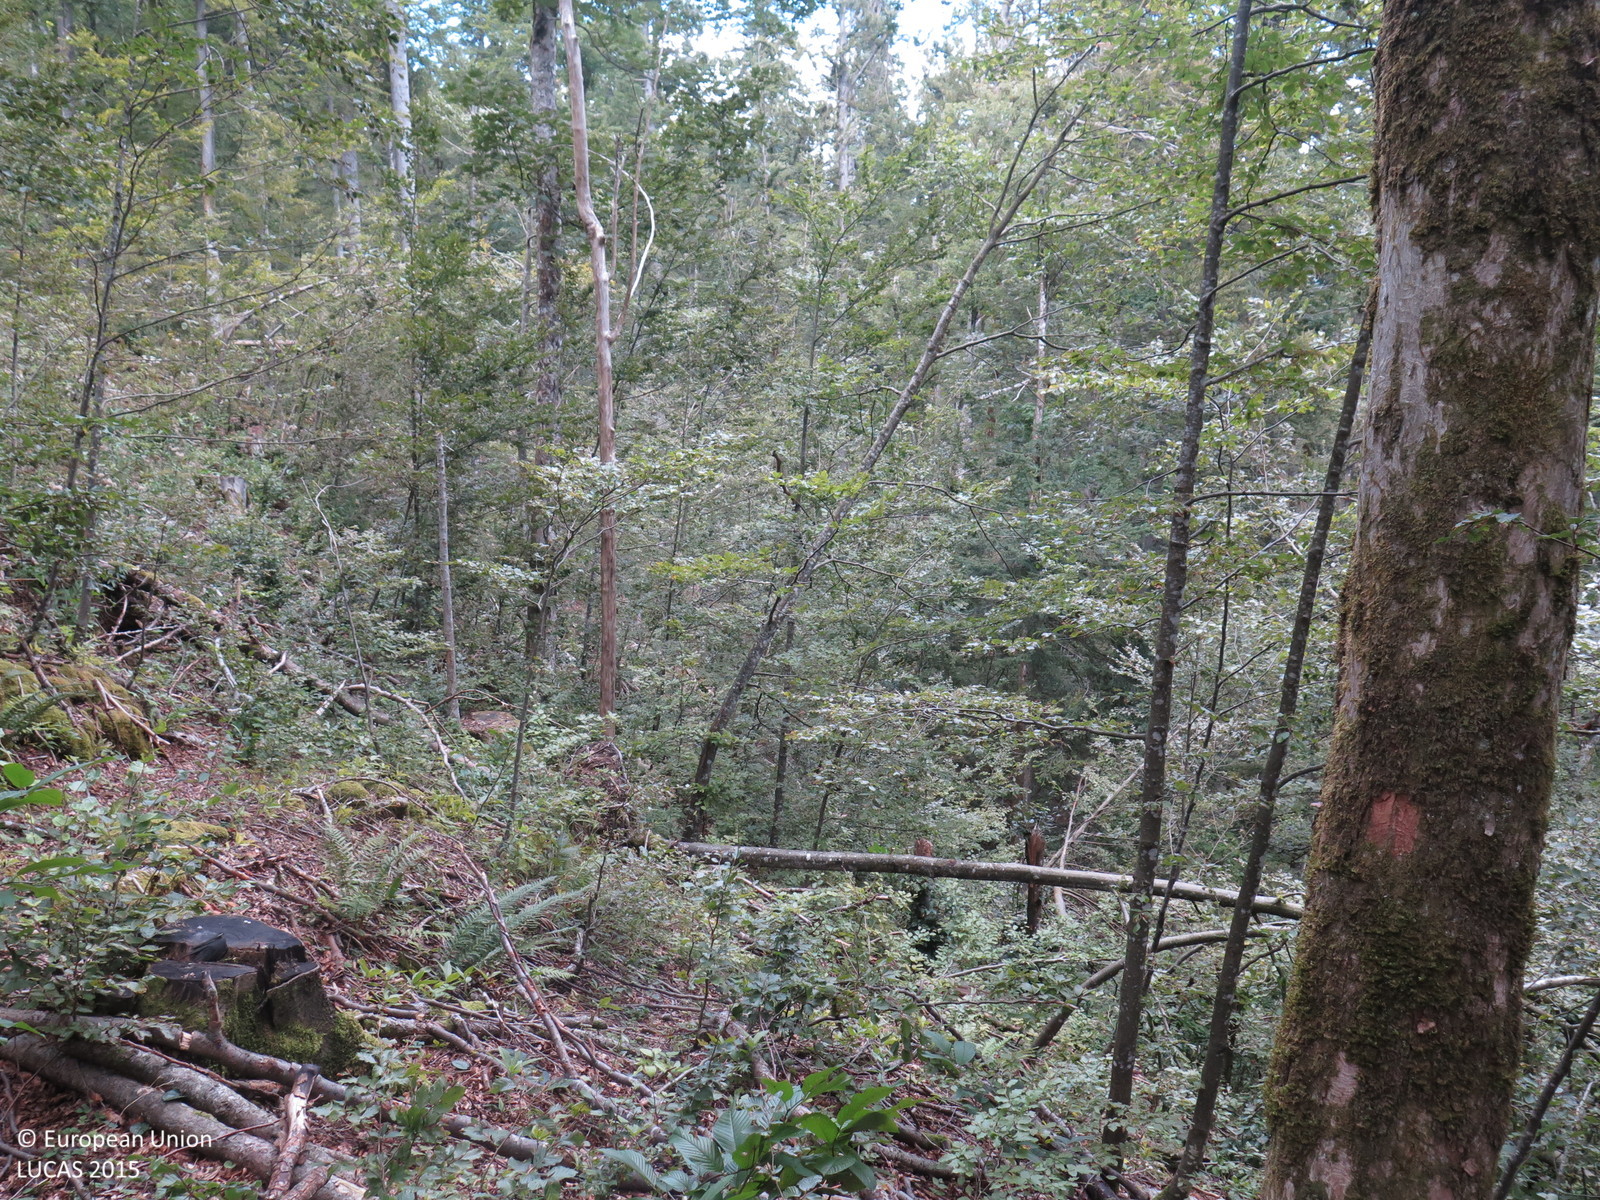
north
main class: Woodland
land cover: Other mixed woodland
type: mountainous beech forest
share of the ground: > 75 %
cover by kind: broadleaved forest trees 75 %, coniferous forest trees 25 %
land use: Forestry
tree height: > 5 m
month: September
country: HR
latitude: 45.3791
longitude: 14.7585
